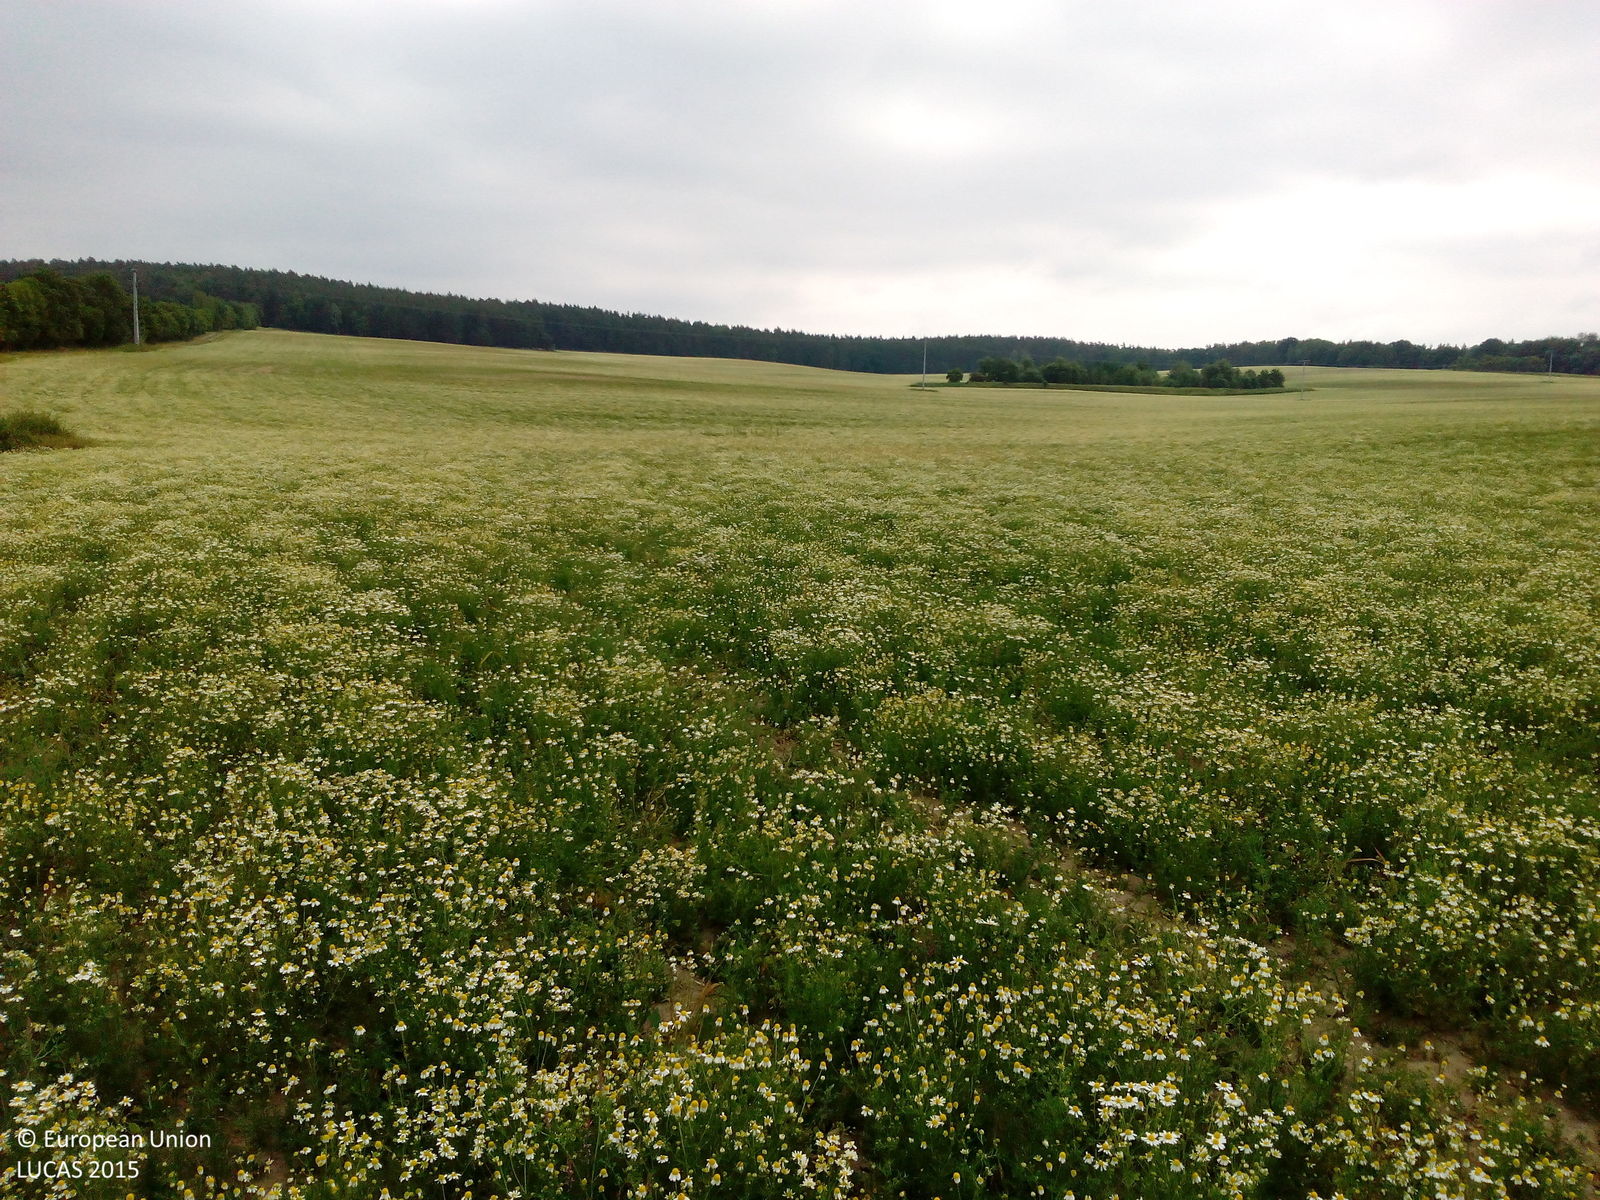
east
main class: Grassland
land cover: Spontaneously vegetated surfaces
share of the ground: > 75 %
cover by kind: herbaceous plants 80 %, unconsolidated bare surface 20 %
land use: Fallow land
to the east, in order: Spontaneously vegetated surfaces
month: June
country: DE
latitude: 50.7133
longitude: 11.5433
